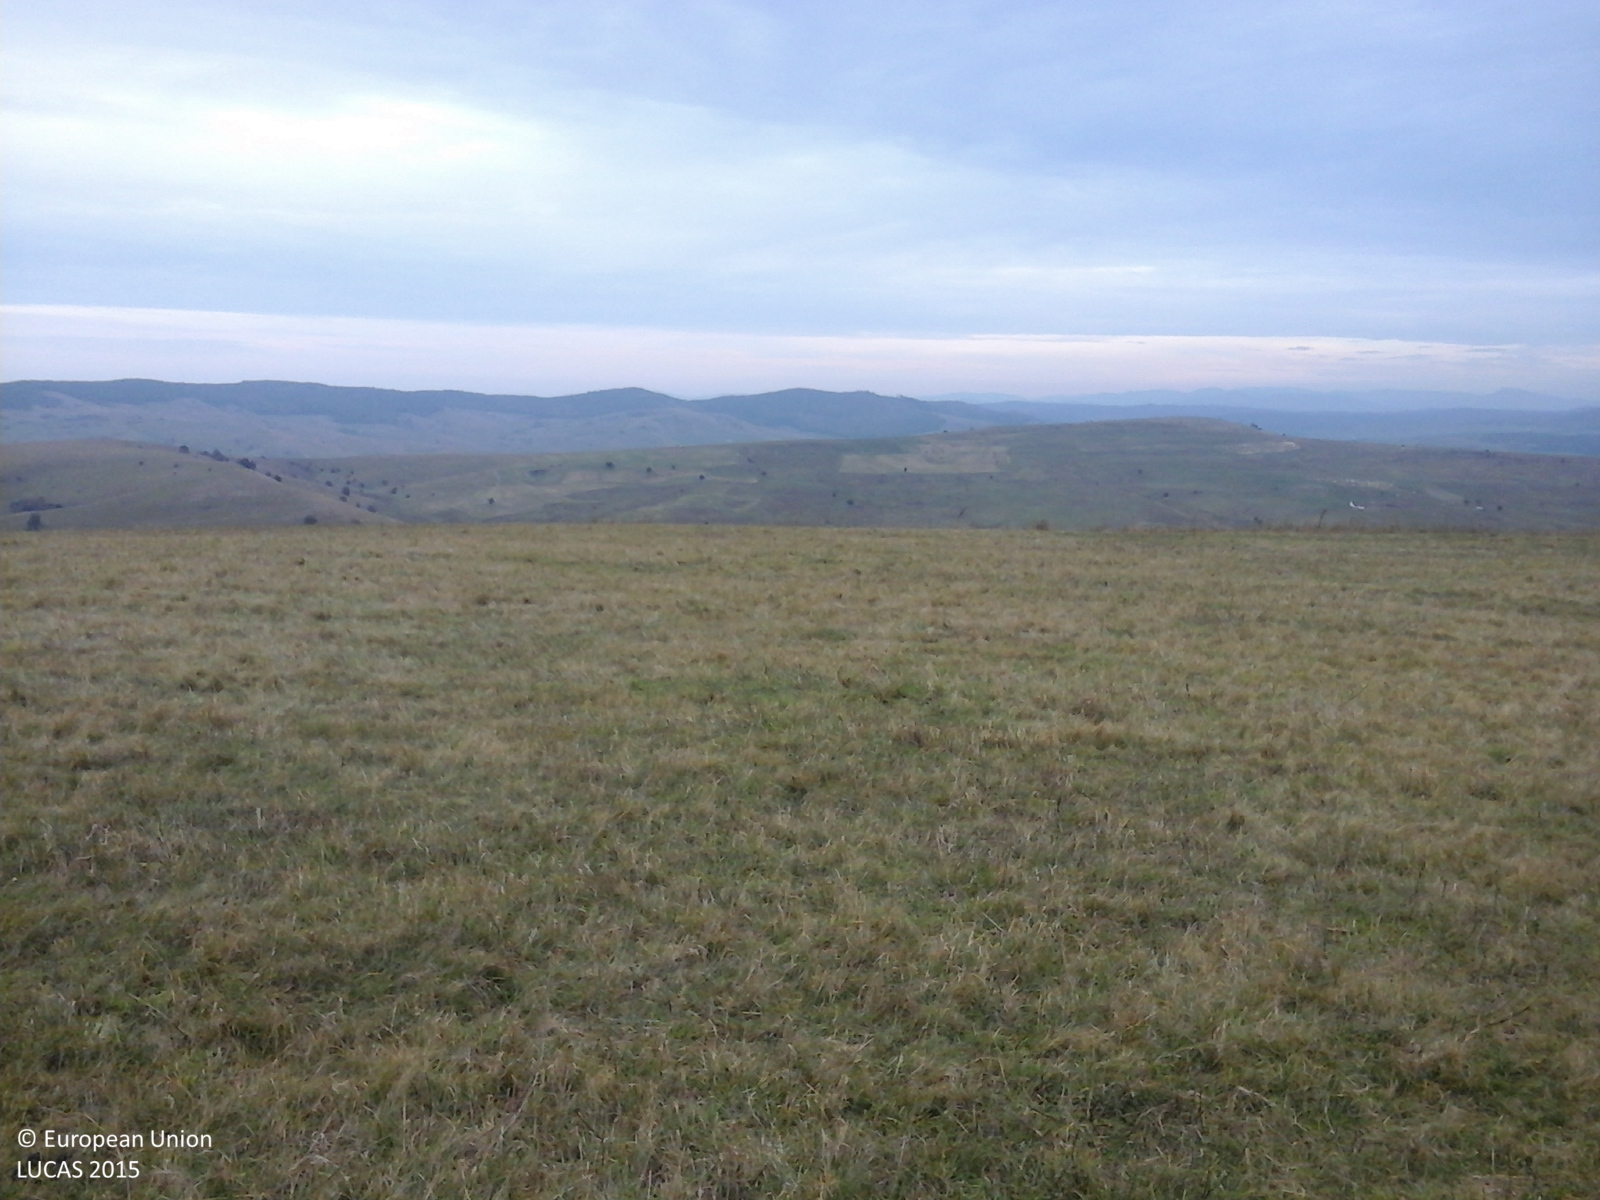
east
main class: Grassland
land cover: Grassland without tree/shrub cover
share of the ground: > 75 %
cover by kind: herbaceous plants 100 %
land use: Agriculture (excluding fallow land and kitchen gardens)
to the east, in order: Grassland without tree/shrub cover; Tracks; Grassland without tree/shrub cover
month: October
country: RO
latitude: 46.0377
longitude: 24.9920
